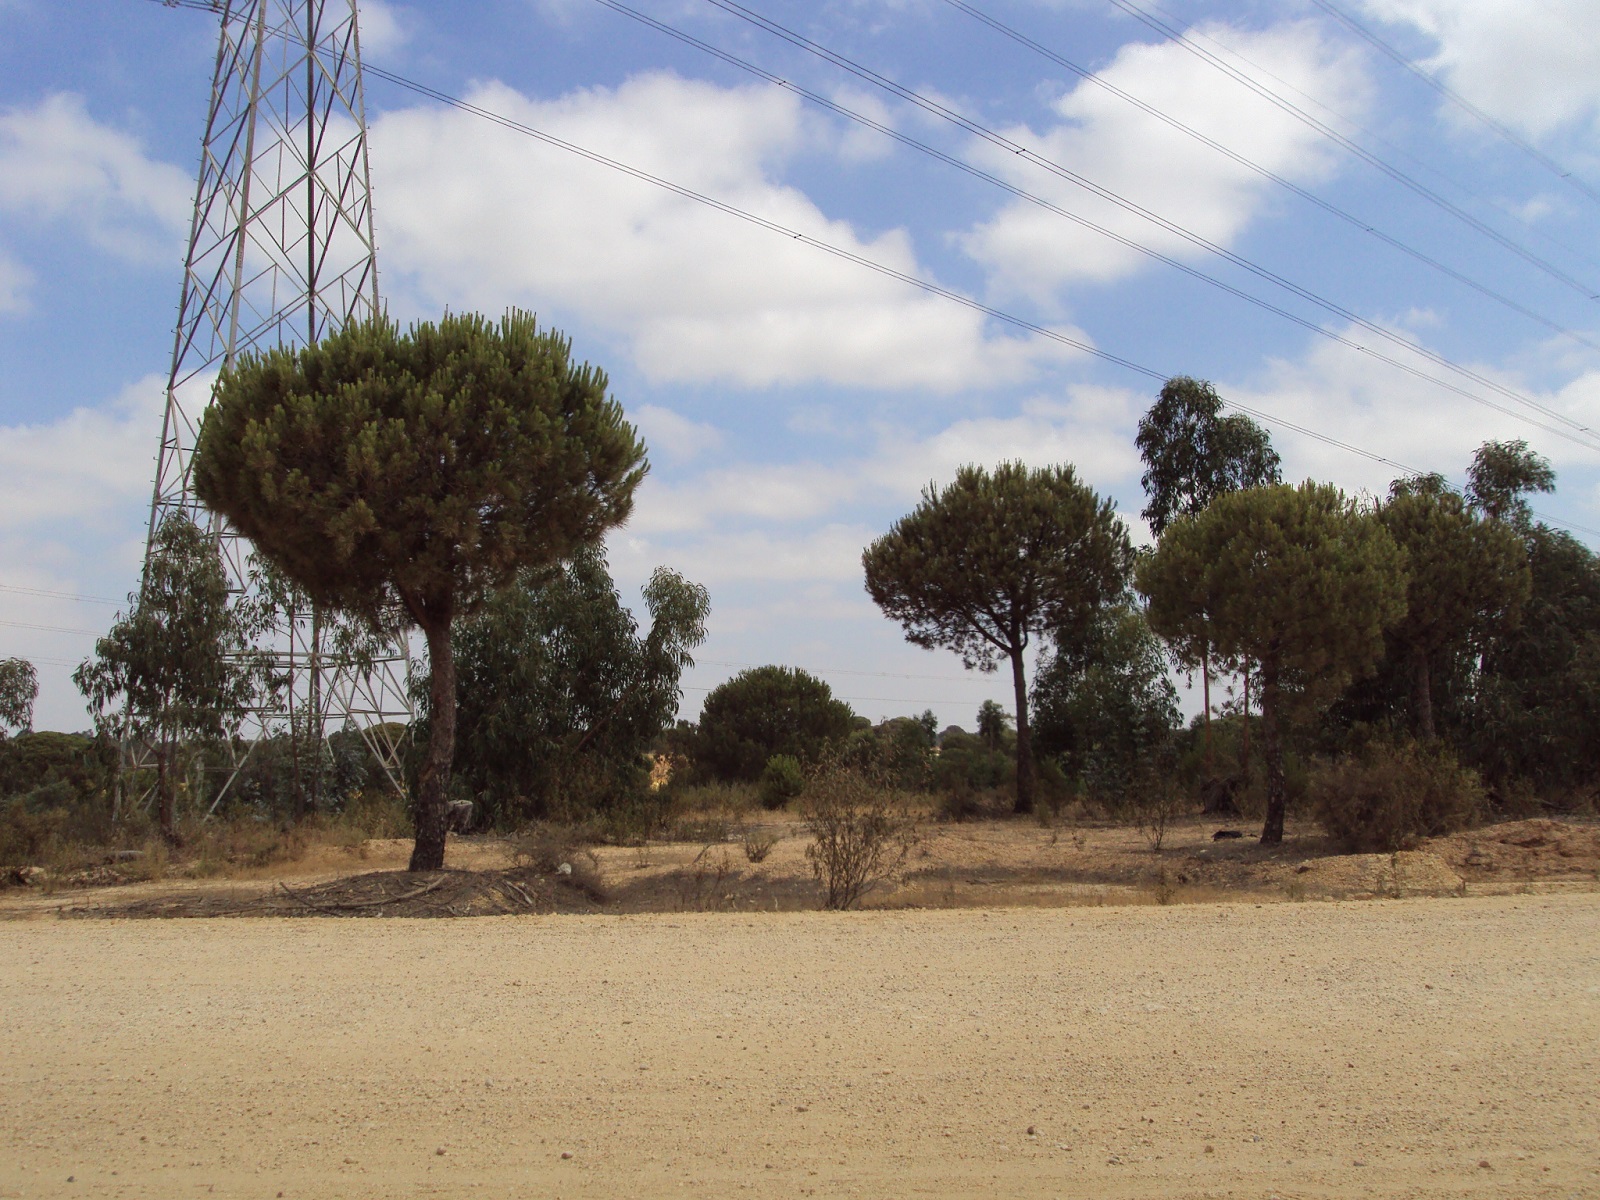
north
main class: Woodland
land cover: Pine dominated coniferous woodland
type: coniferous forest of the mediterranean region
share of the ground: 50 - 75 %
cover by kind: coniferous forest trees 60 %, herbaceous plants 30 %, shrubs 10 %
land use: Forestry
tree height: > 5 m
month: June
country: ES
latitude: 37.2273
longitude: -6.8630
